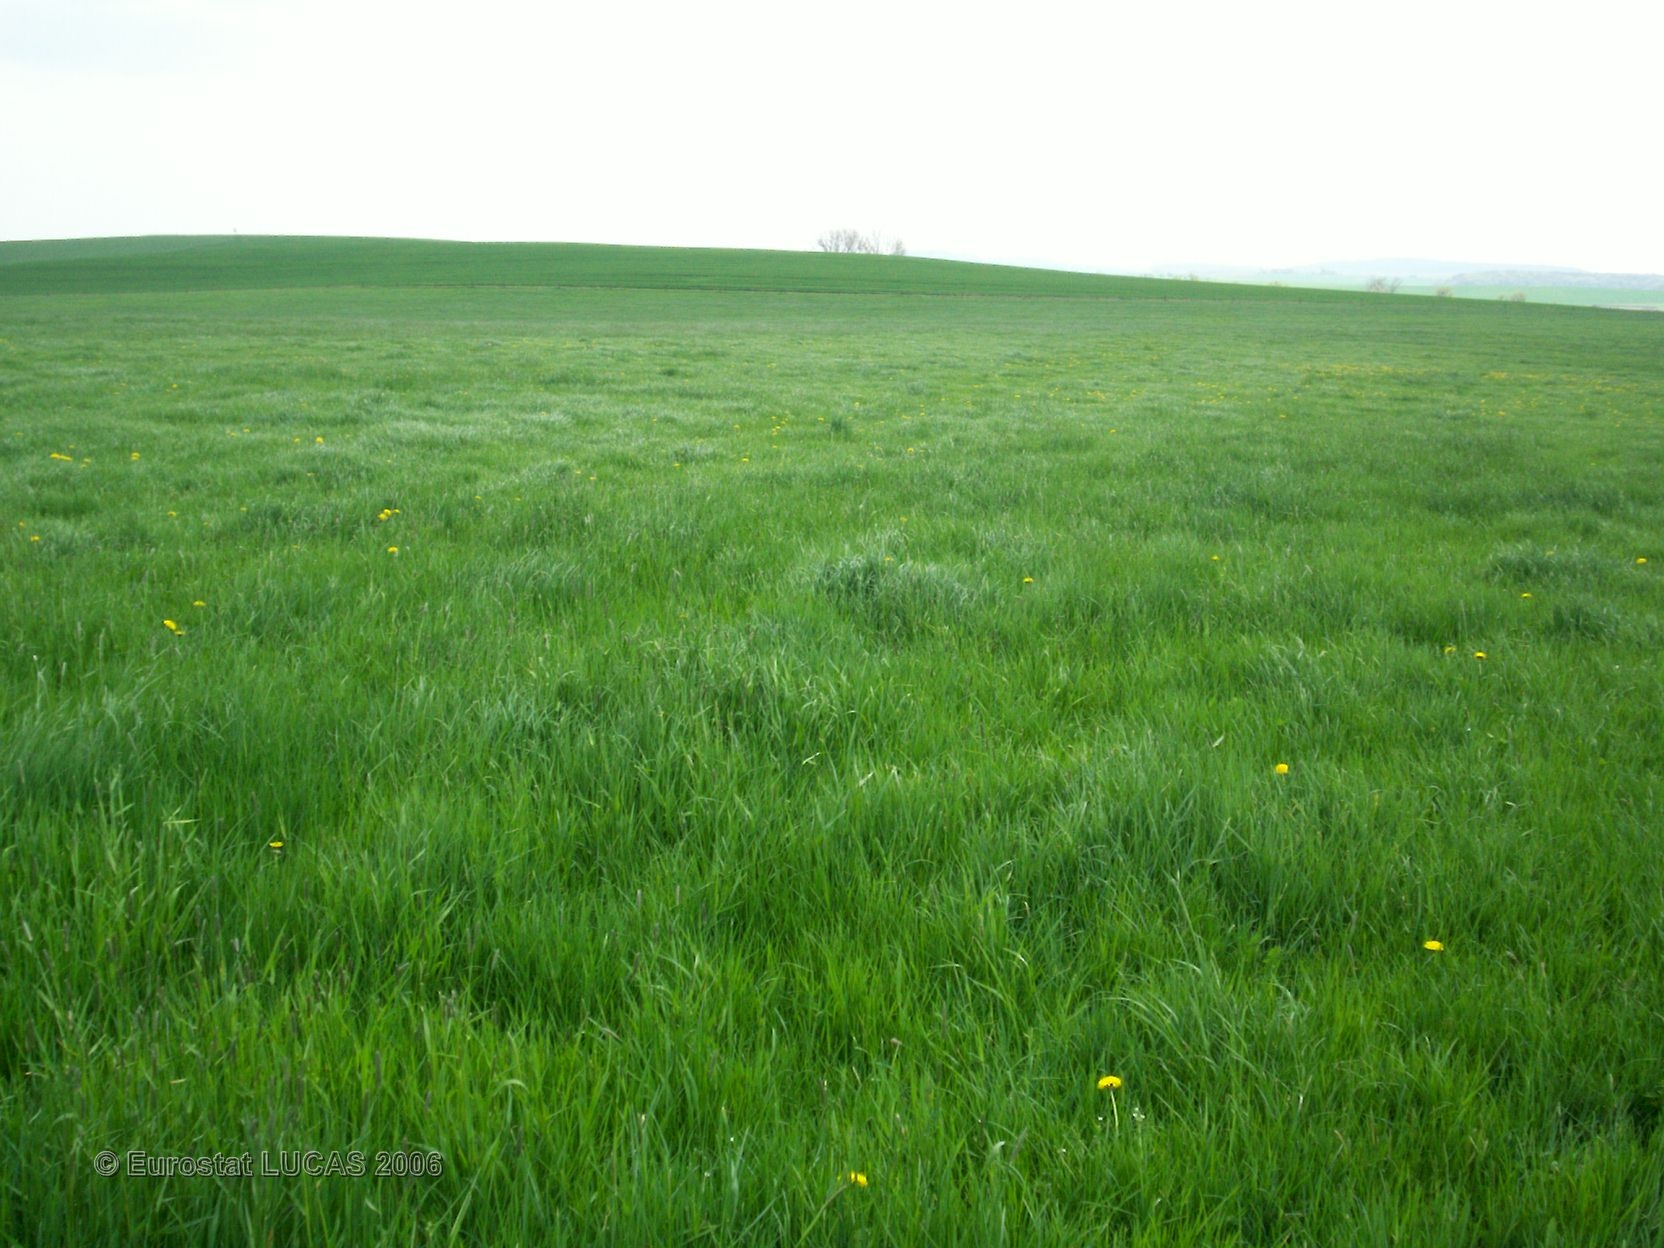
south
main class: Grassland
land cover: Grassland without tree/shrub cover
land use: Agriculture (excluding fallow land and kitchen gardens)
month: April
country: FR
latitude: 48.9675
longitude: 6.7356
